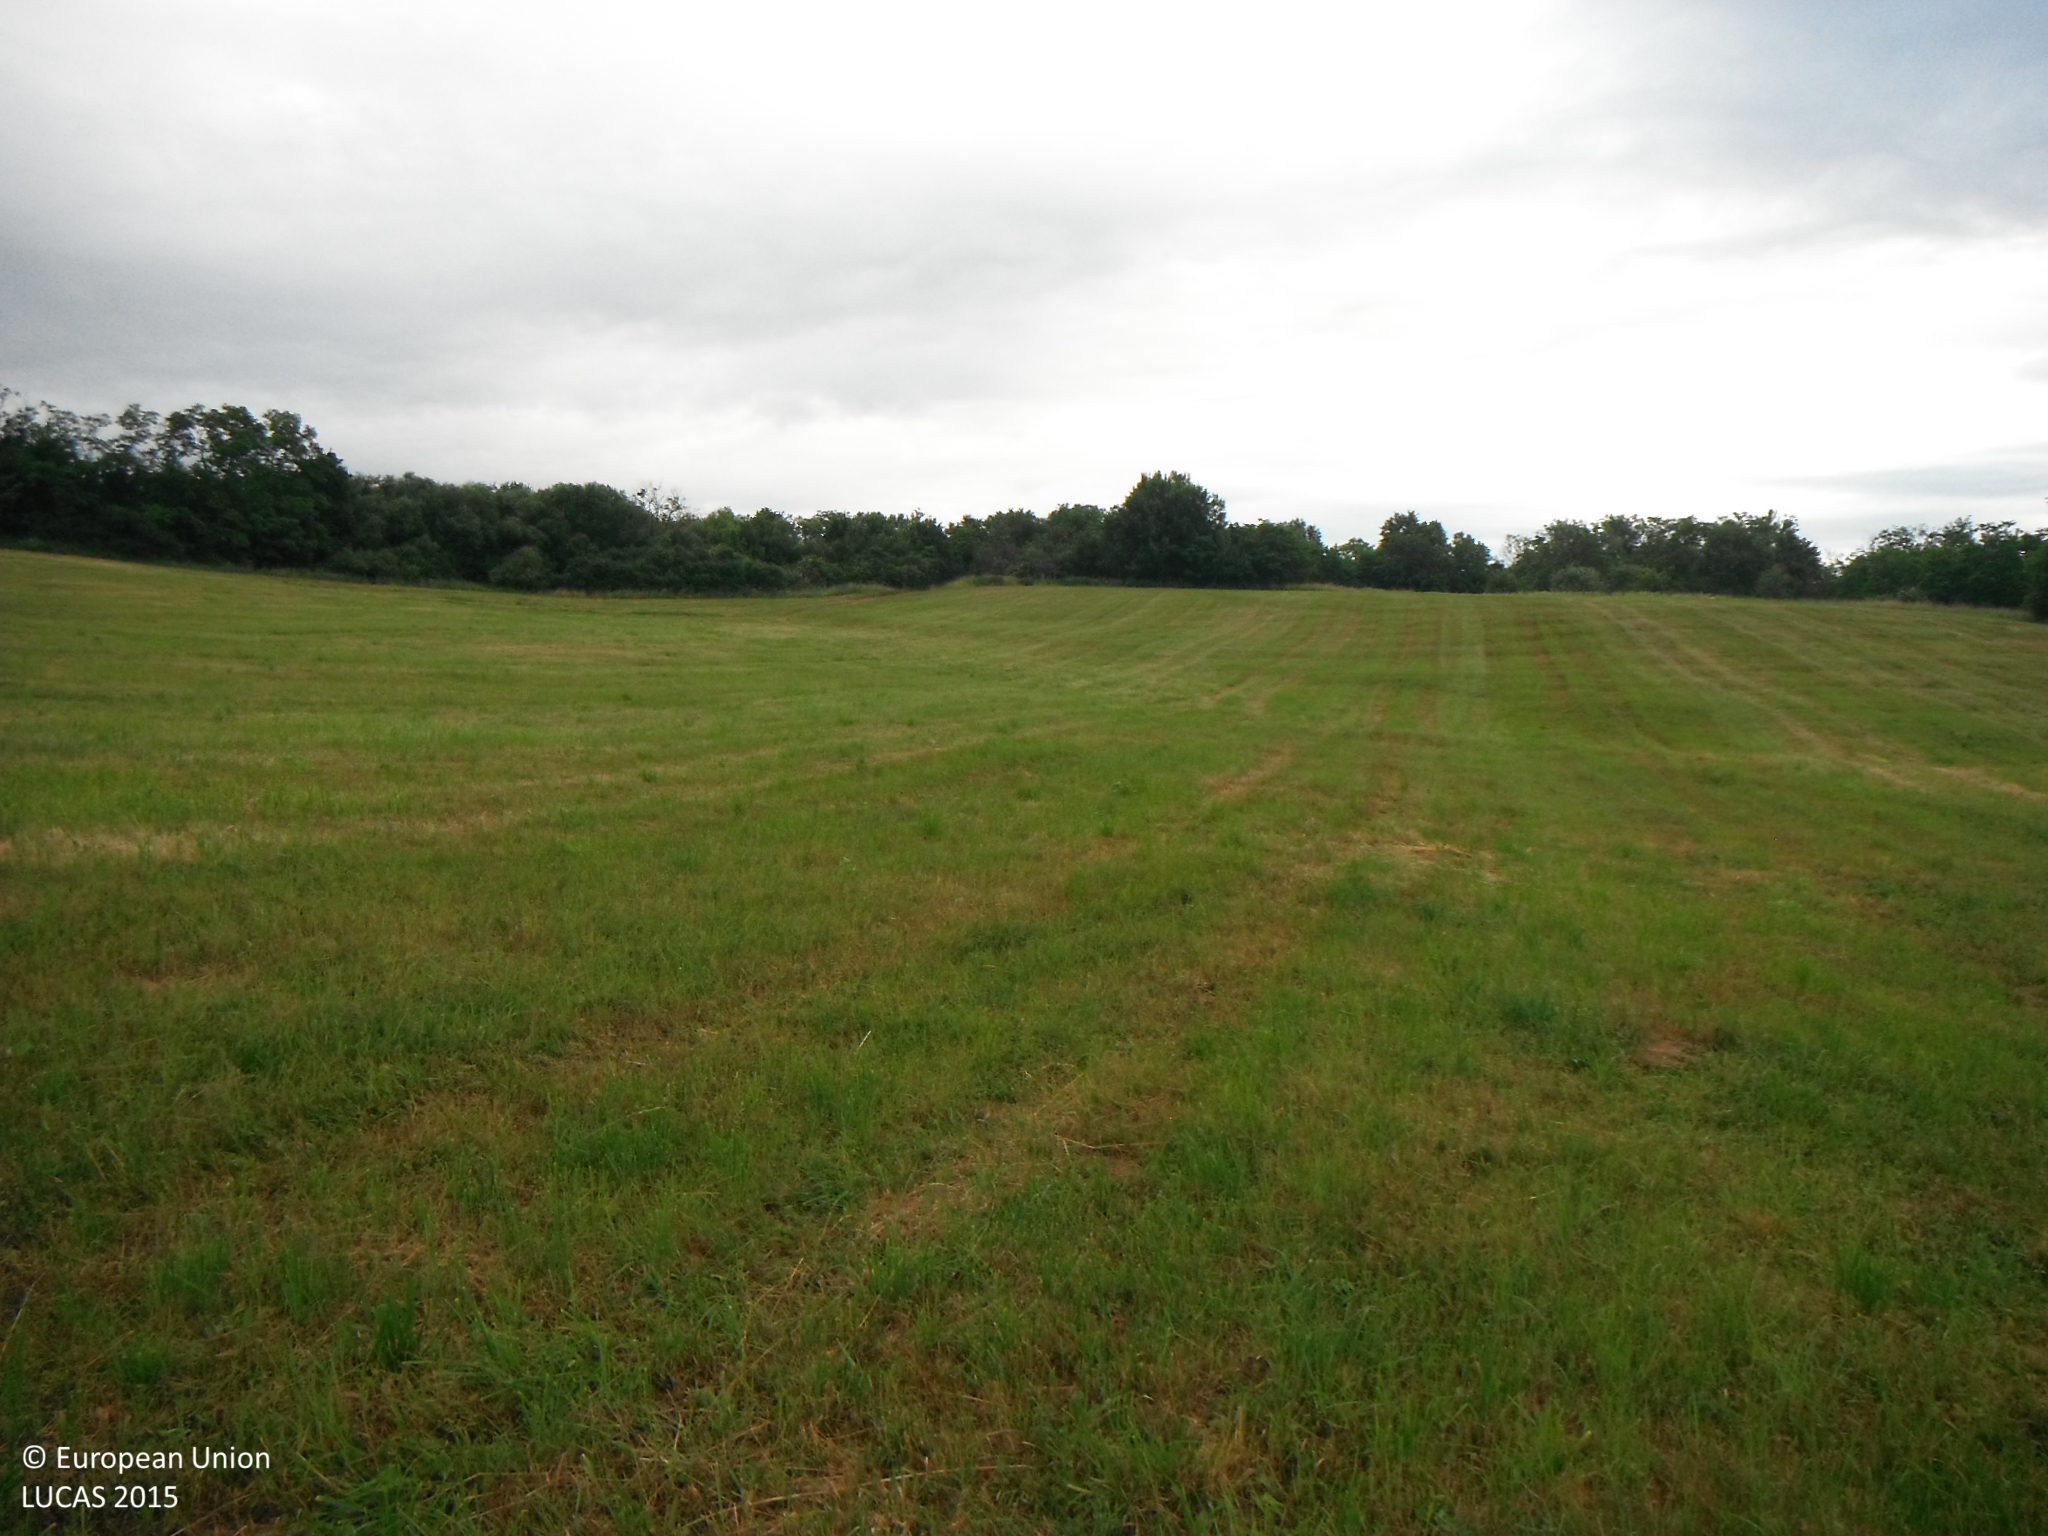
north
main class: Grassland
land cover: Grassland without tree/shrub cover
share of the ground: > 75 %
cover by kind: herbaceous plants 100 %
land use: Agriculture (excluding fallow land and kitchen gardens)
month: June
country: SK
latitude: 48.3308
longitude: 19.3710
